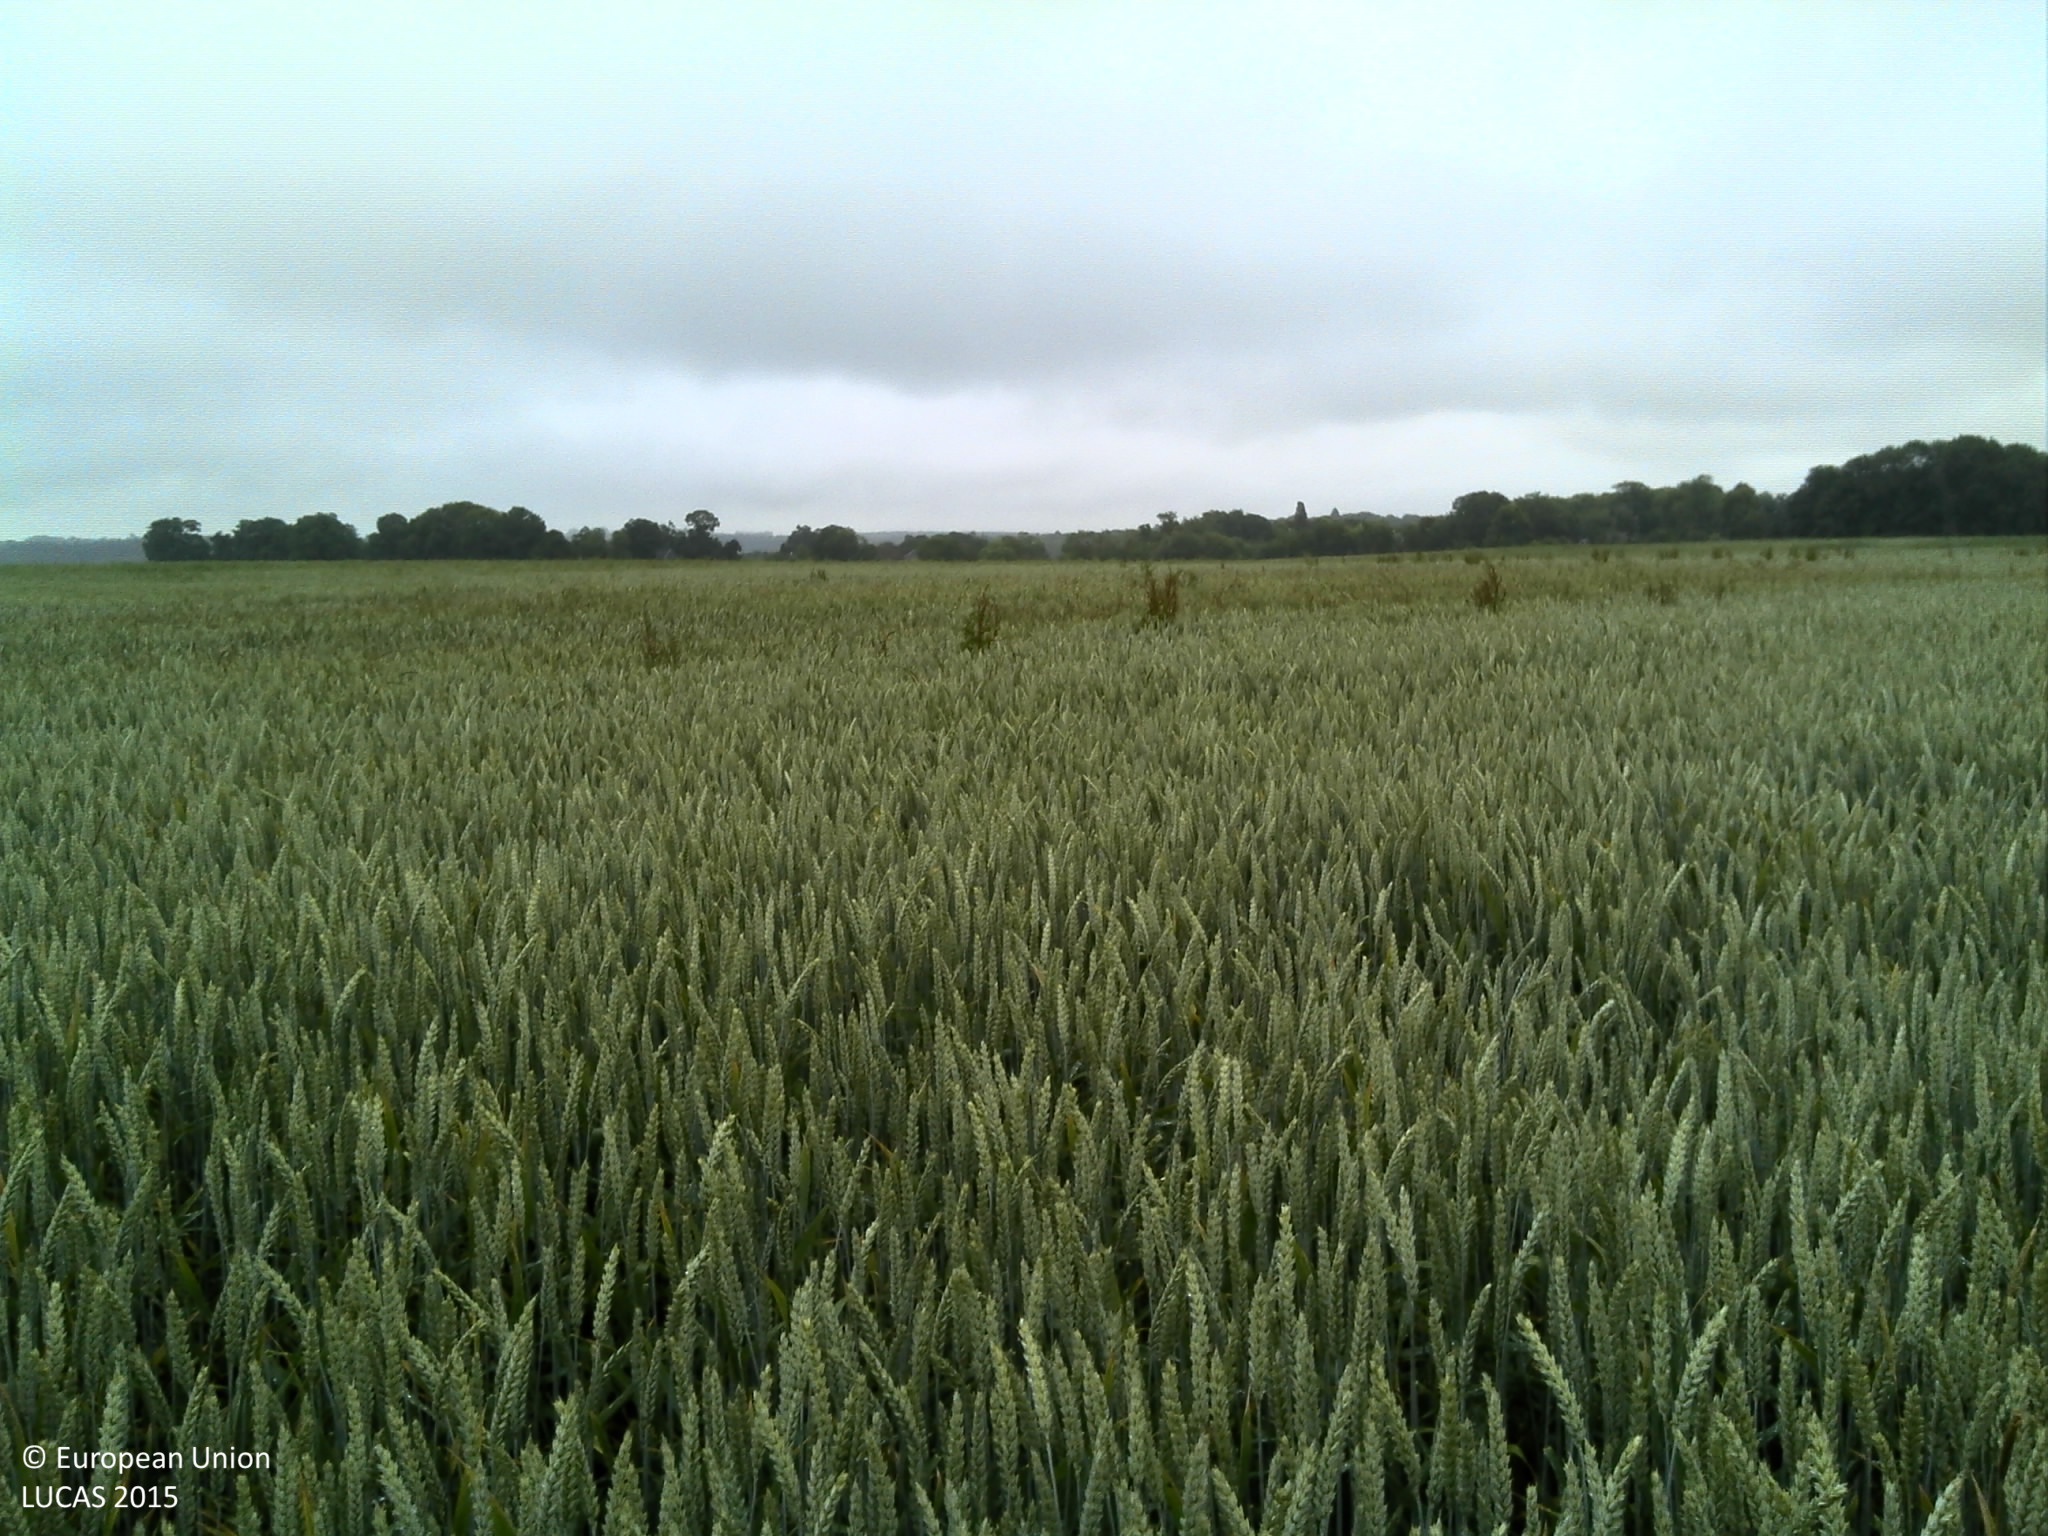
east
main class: Cropland
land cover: Common wheat
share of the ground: > 75 %
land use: Agriculture (excluding fallow land and kitchen gardens)
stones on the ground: 10 - 25 %
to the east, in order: Common wheat; Oats; Common wheat; Oats; Rape and turnip rape
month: June
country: FR
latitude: 49.4228
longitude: 1.1419
